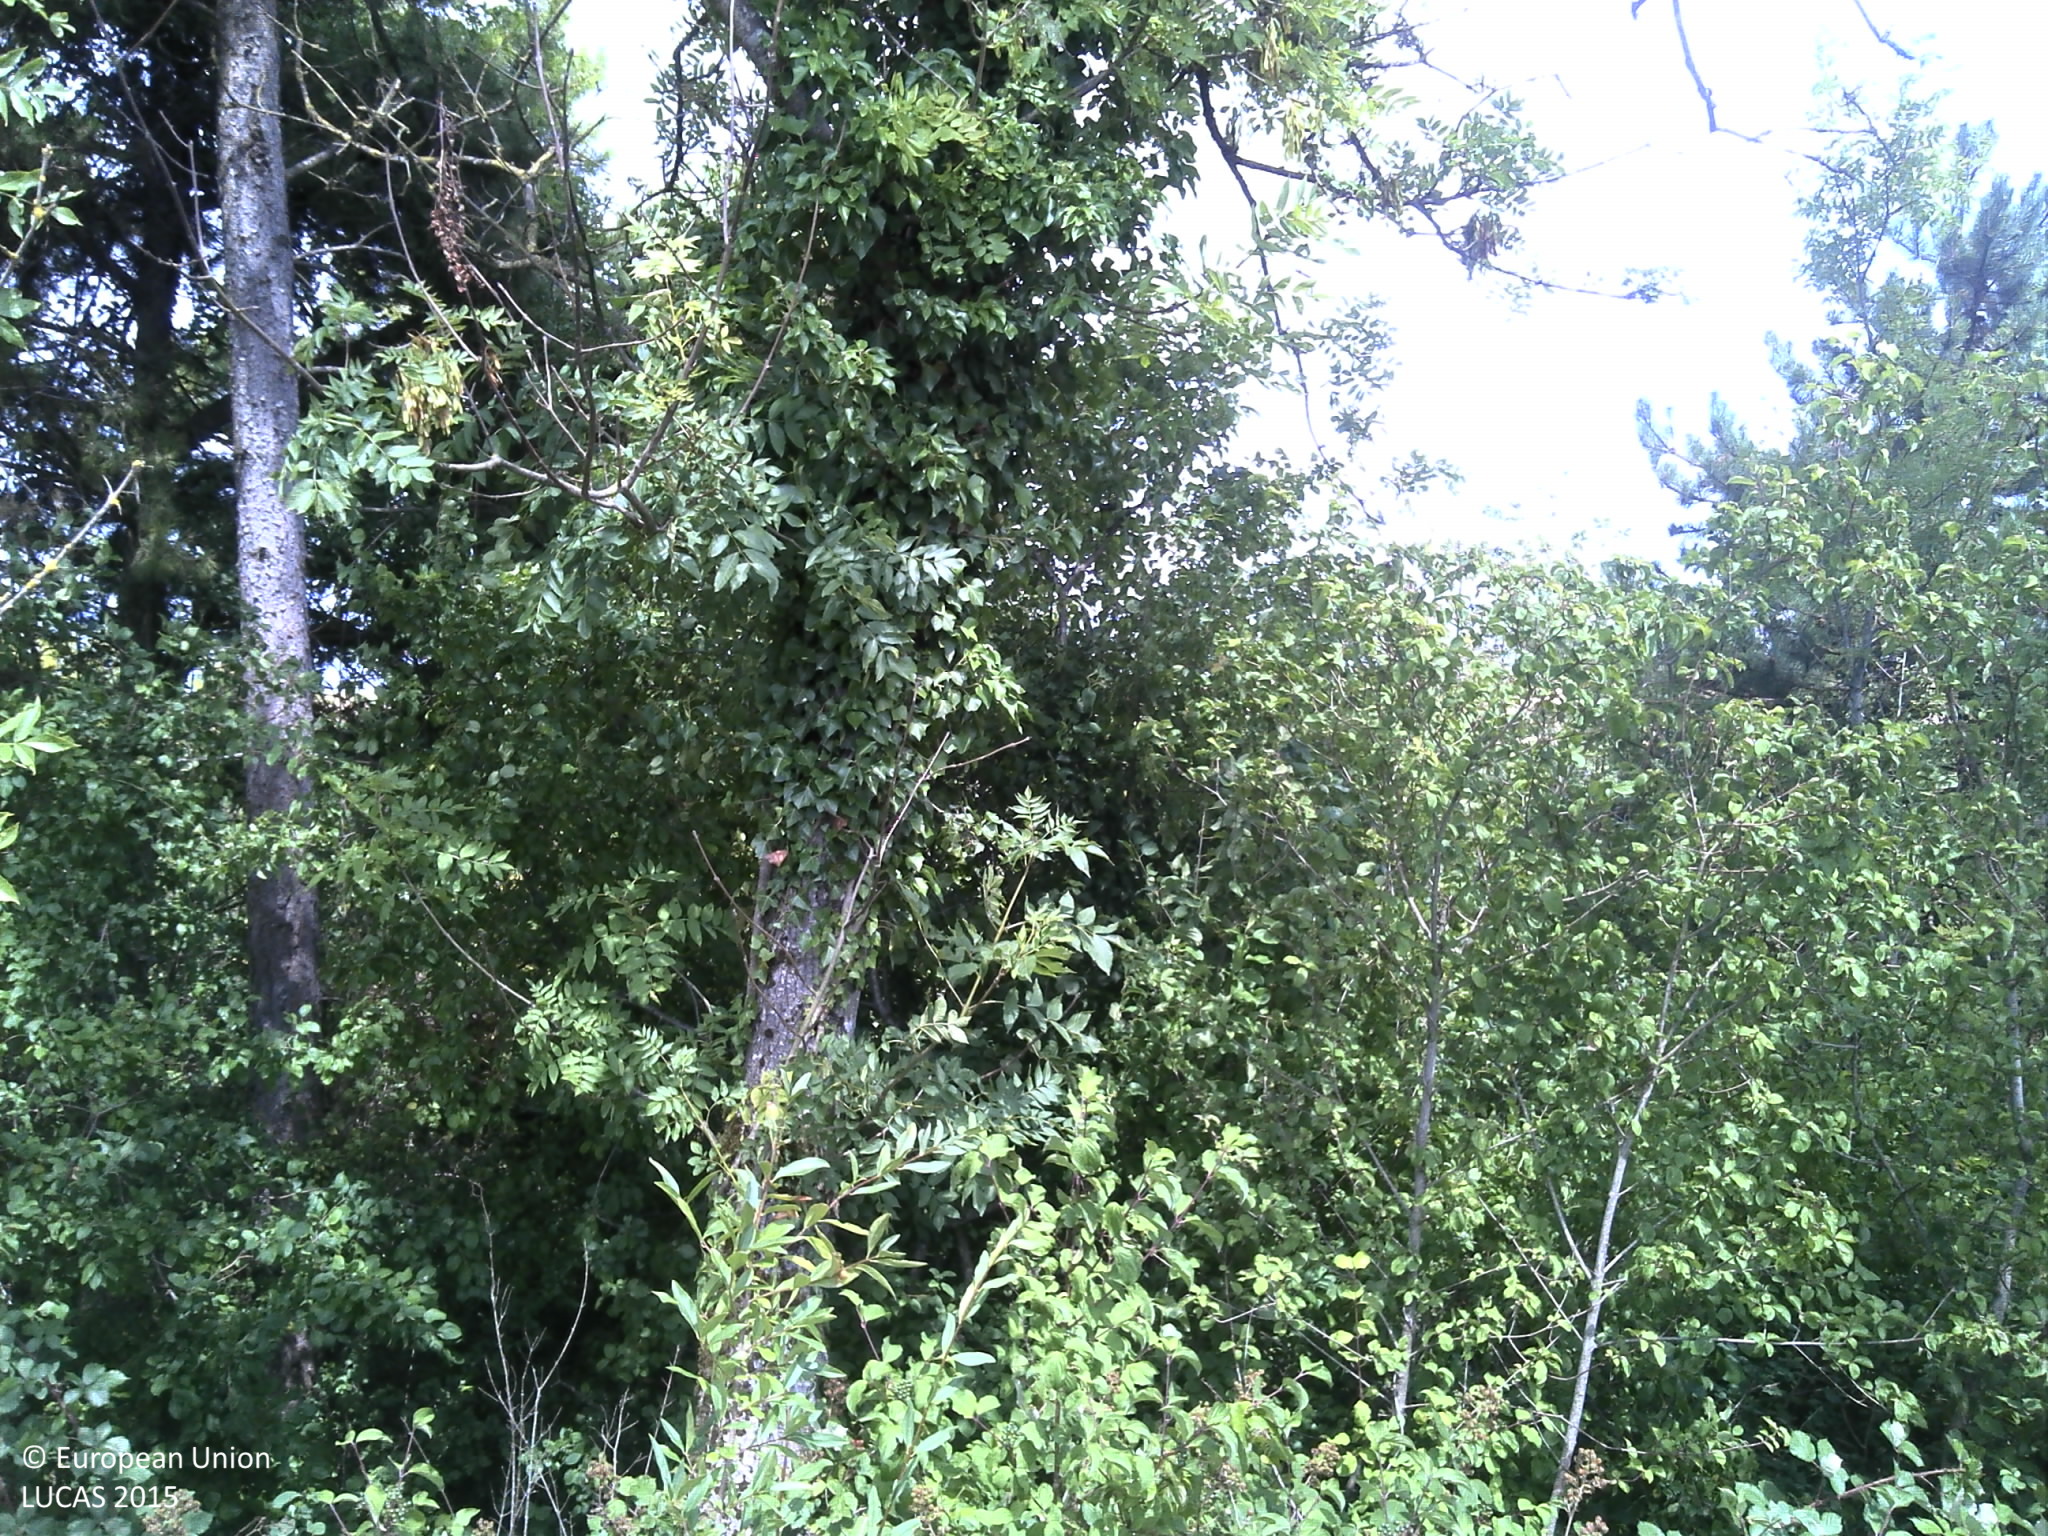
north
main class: Woodland
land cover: Pine dominated mixed woodland
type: alpine coniferous forest
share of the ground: > 75 %
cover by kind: coniferous forest trees 40 %, herbaceous plants 40 %, broadleaved forest trees 20 %
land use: Forestry
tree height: > 5 m
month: July
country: FR
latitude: 49.3195
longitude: 4.6452
